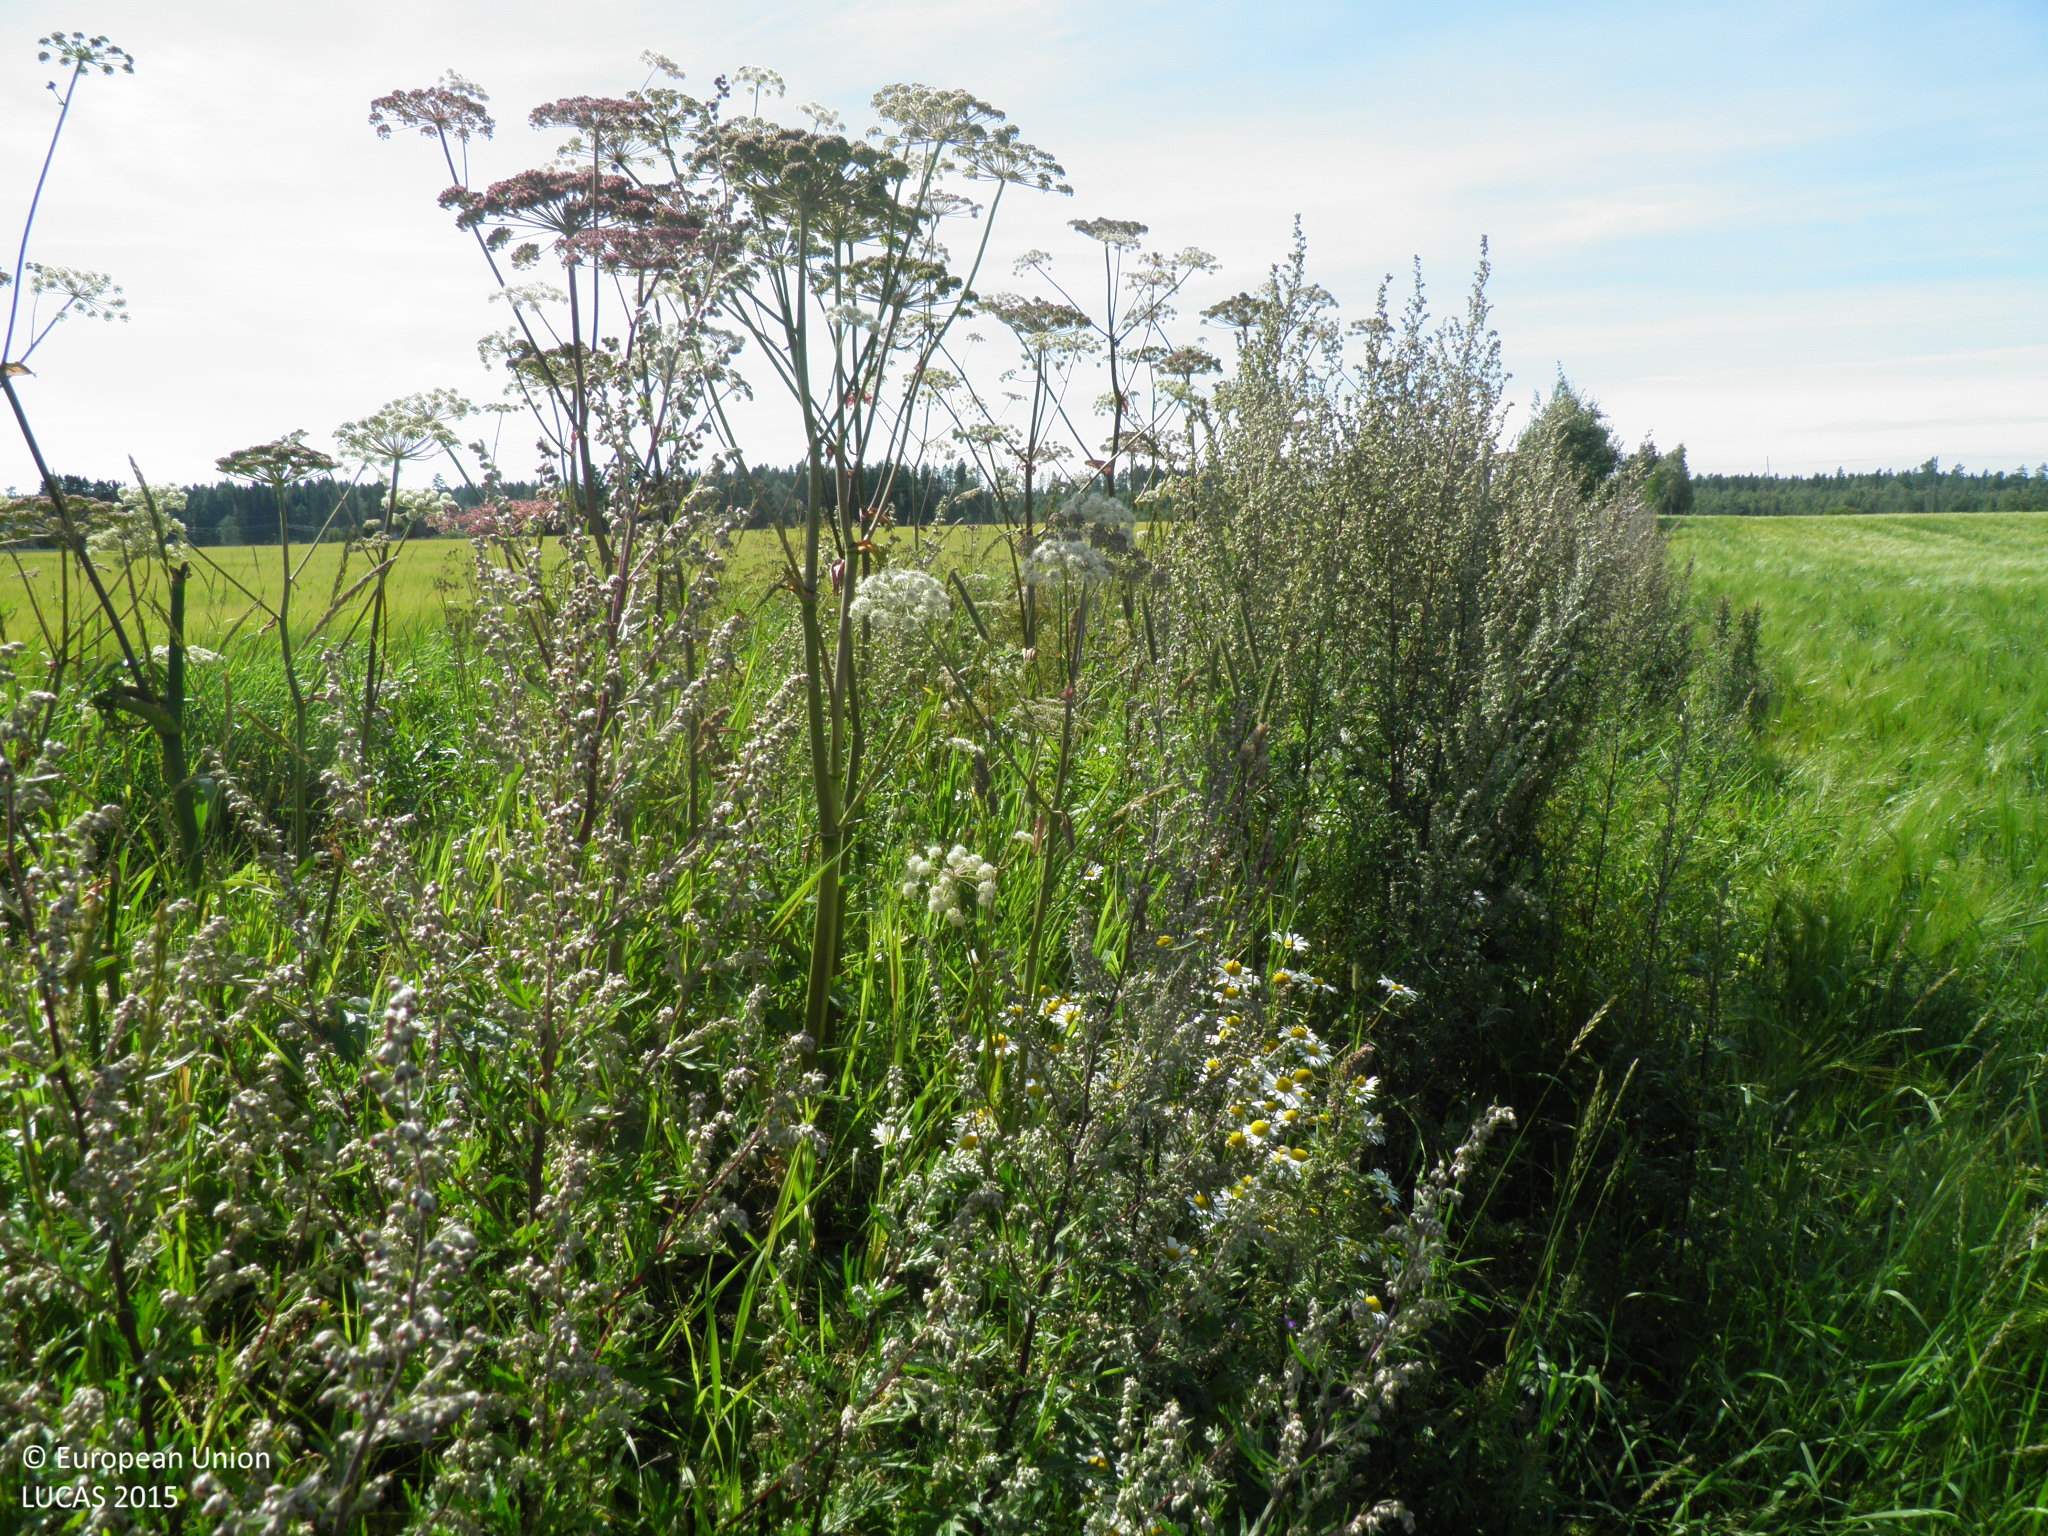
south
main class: Cropland
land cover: Barley
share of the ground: > 75 %
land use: Agriculture (excluding fallow land and kitchen gardens)
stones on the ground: < 10 %
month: August
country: FI
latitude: 61.0041
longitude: 22.7759
